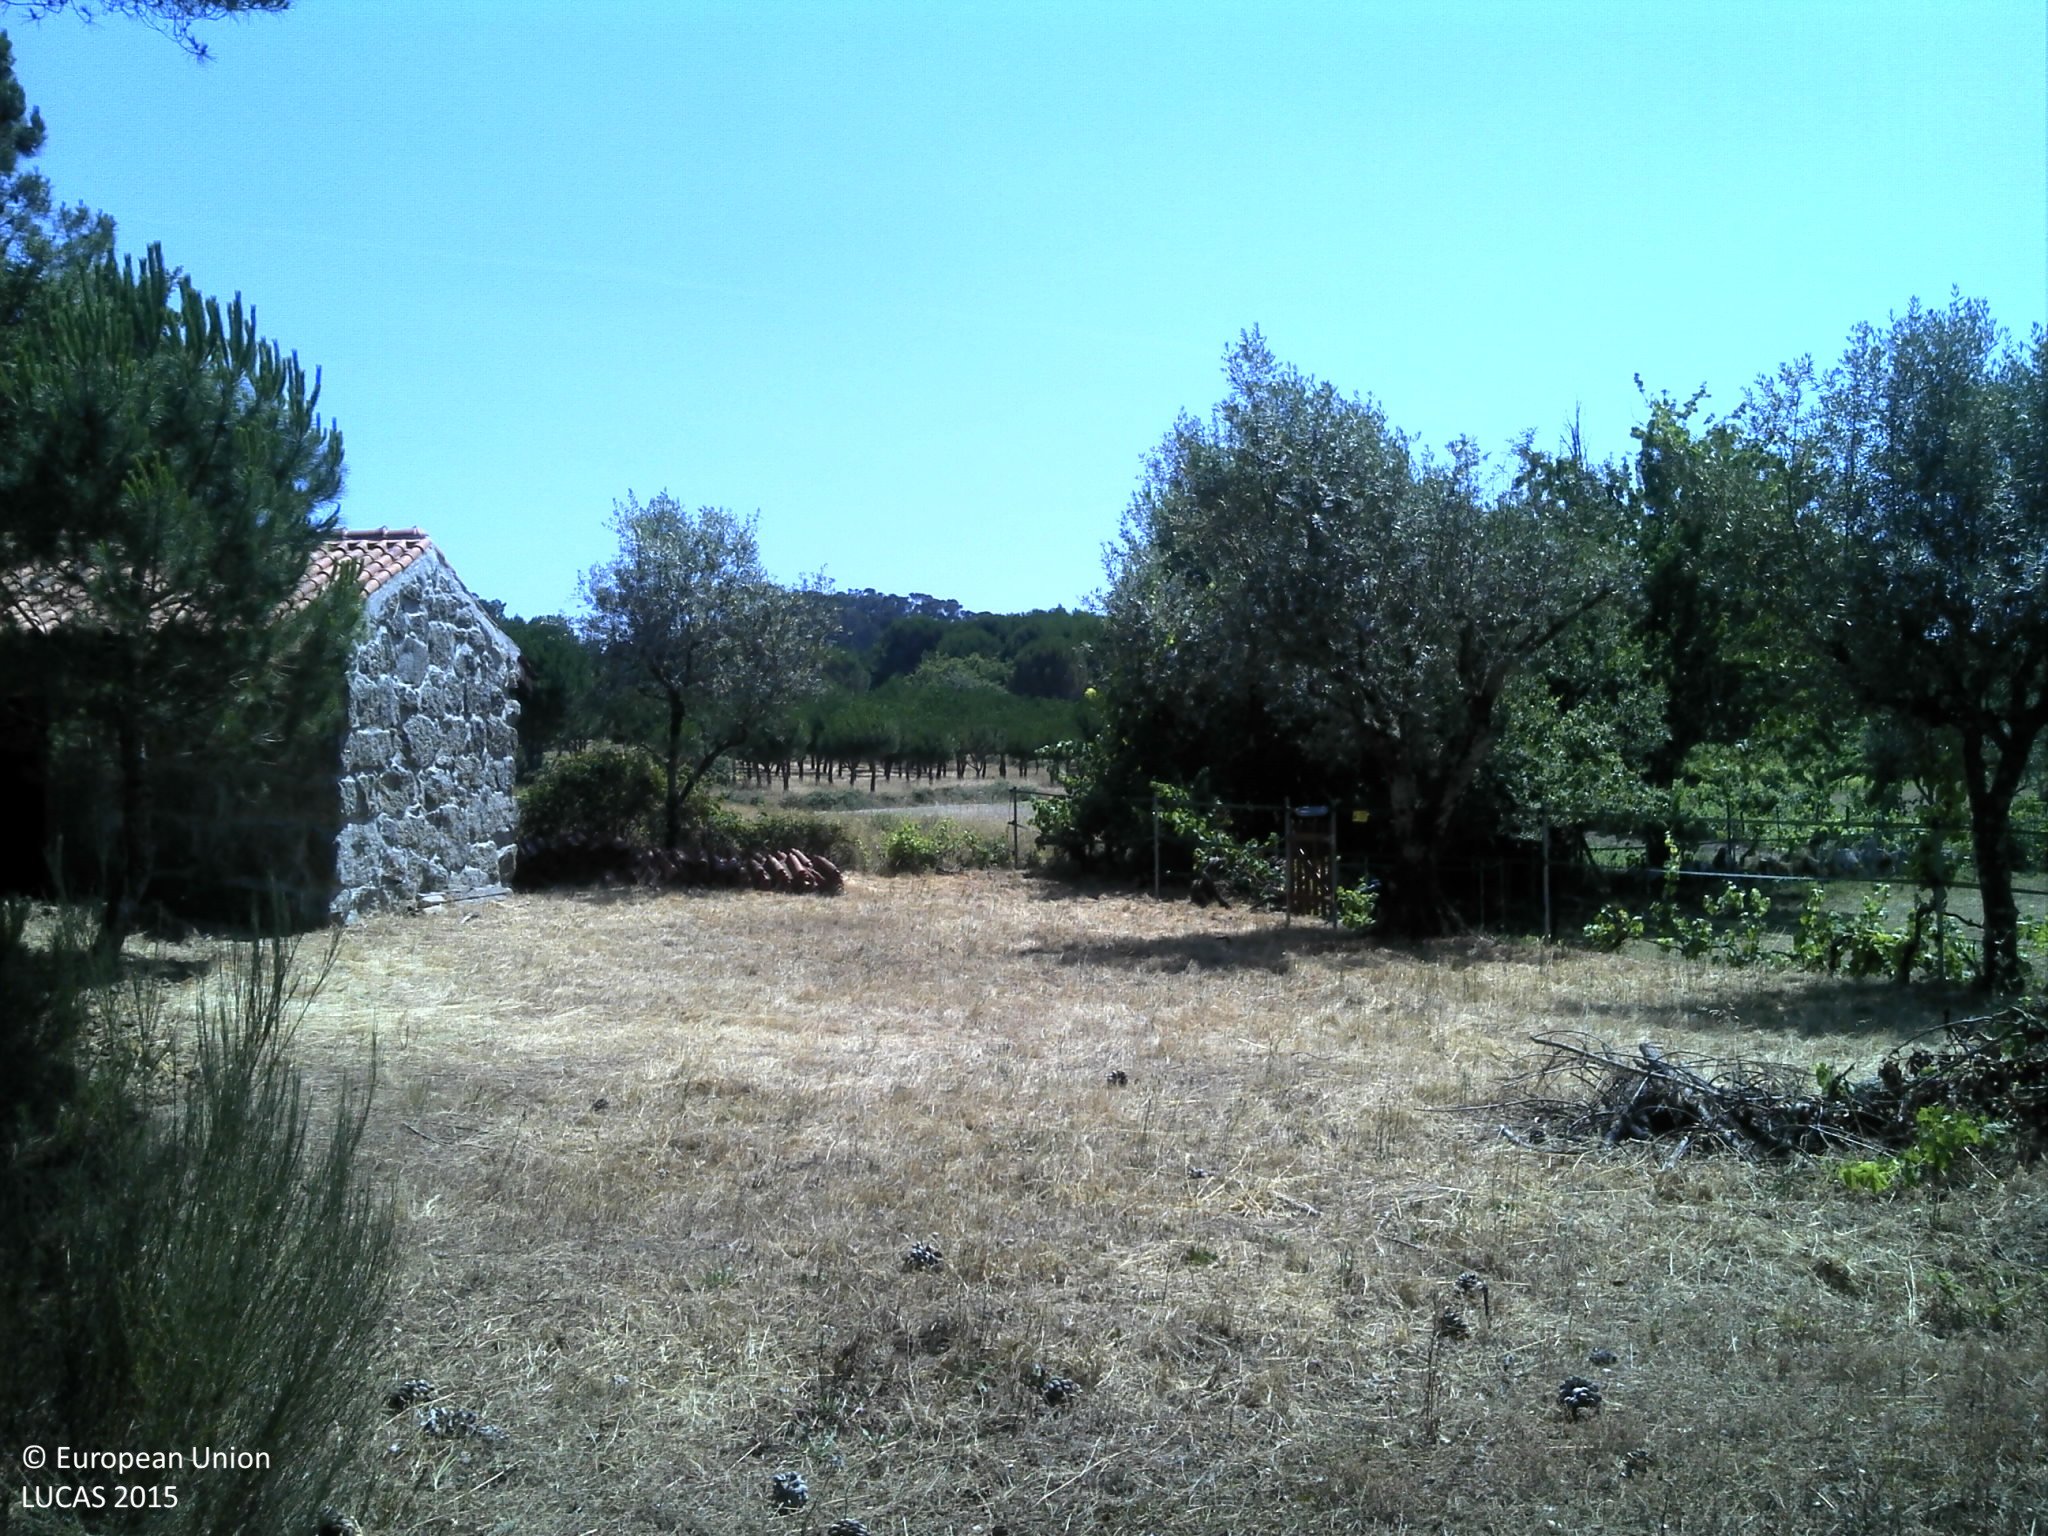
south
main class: Woodland
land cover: Pine dominated coniferous woodland
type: coniferous forest of the mediterranean region
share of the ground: 50 - 75 %
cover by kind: coniferous forest trees 60 %, unconsolidated bare surface 25 %, shrubs 10 %, herbaceous plants 5 %
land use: Forestry
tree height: > 5 m
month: July
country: PT
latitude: 40.3939
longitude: -7.9215
